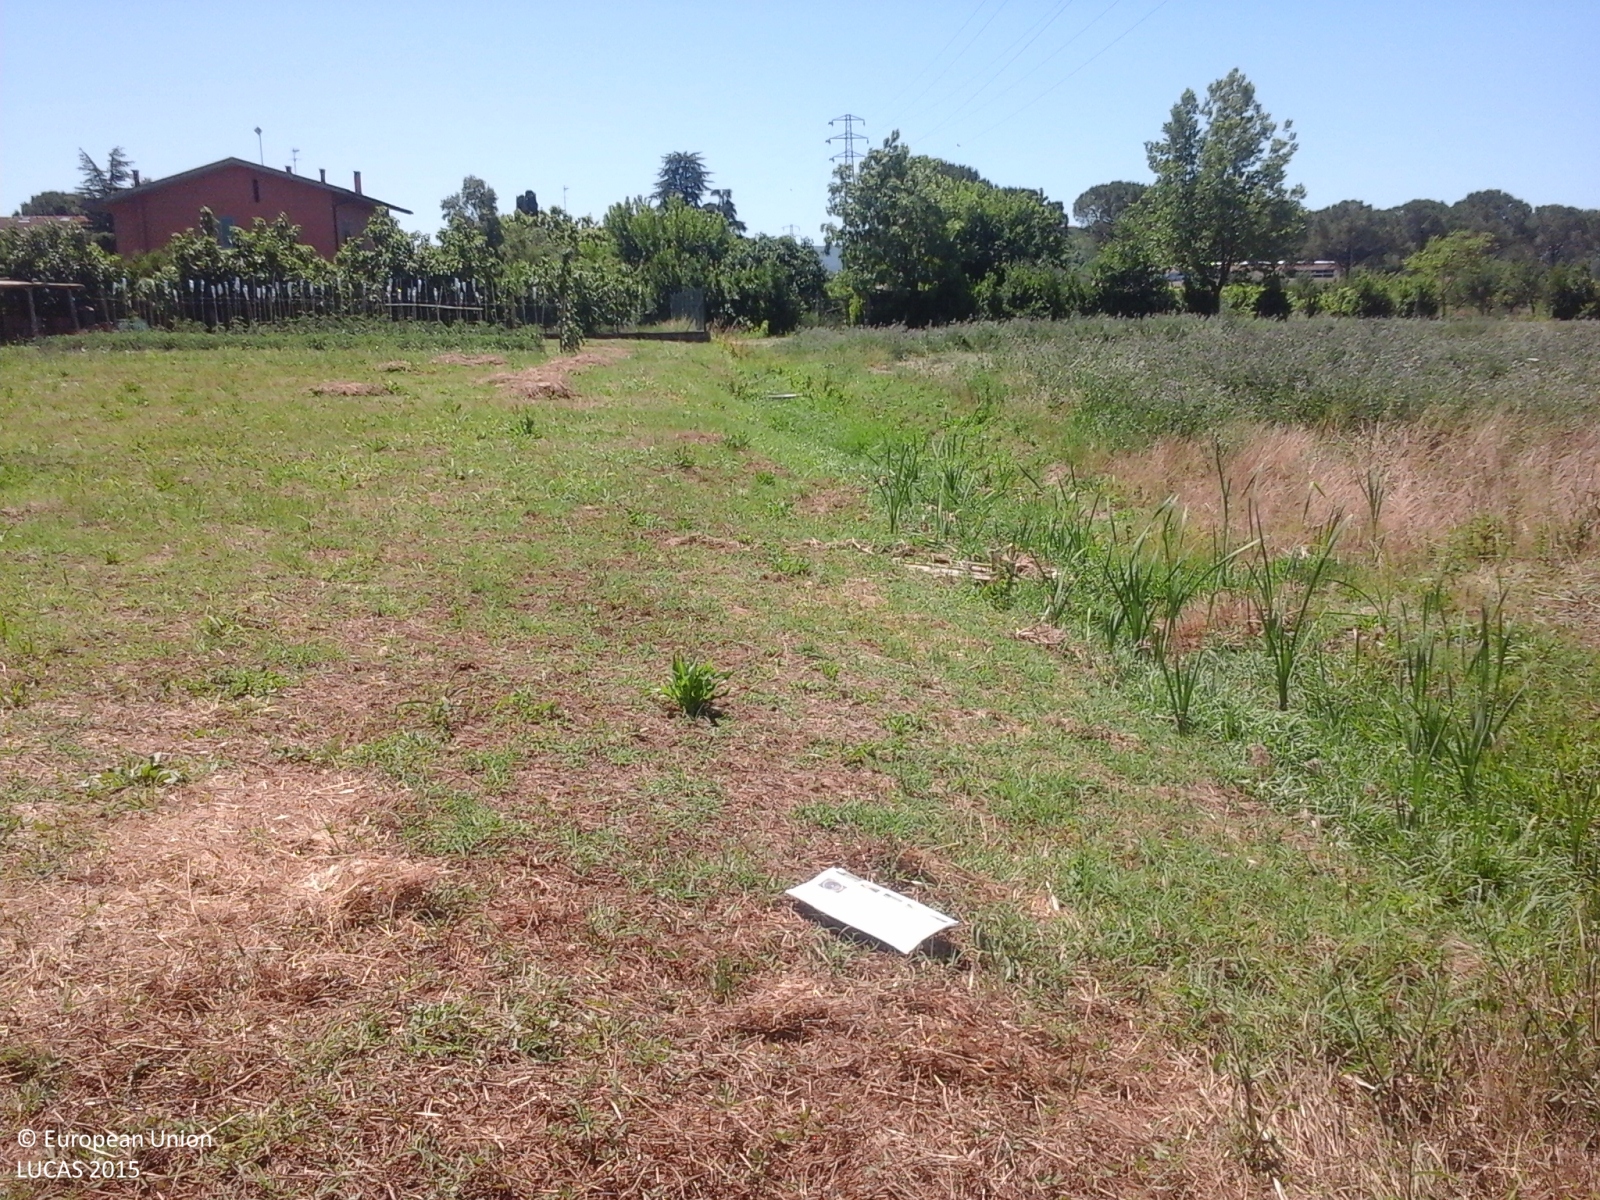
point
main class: Grassland
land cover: Grassland without tree/shrub cover
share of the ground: > 75 %
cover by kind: herbaceous plants 100 %
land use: Agriculture (excluding fallow land and kitchen gardens)
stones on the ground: < 10 %
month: June
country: IT
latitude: 43.5909
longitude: 10.6299
